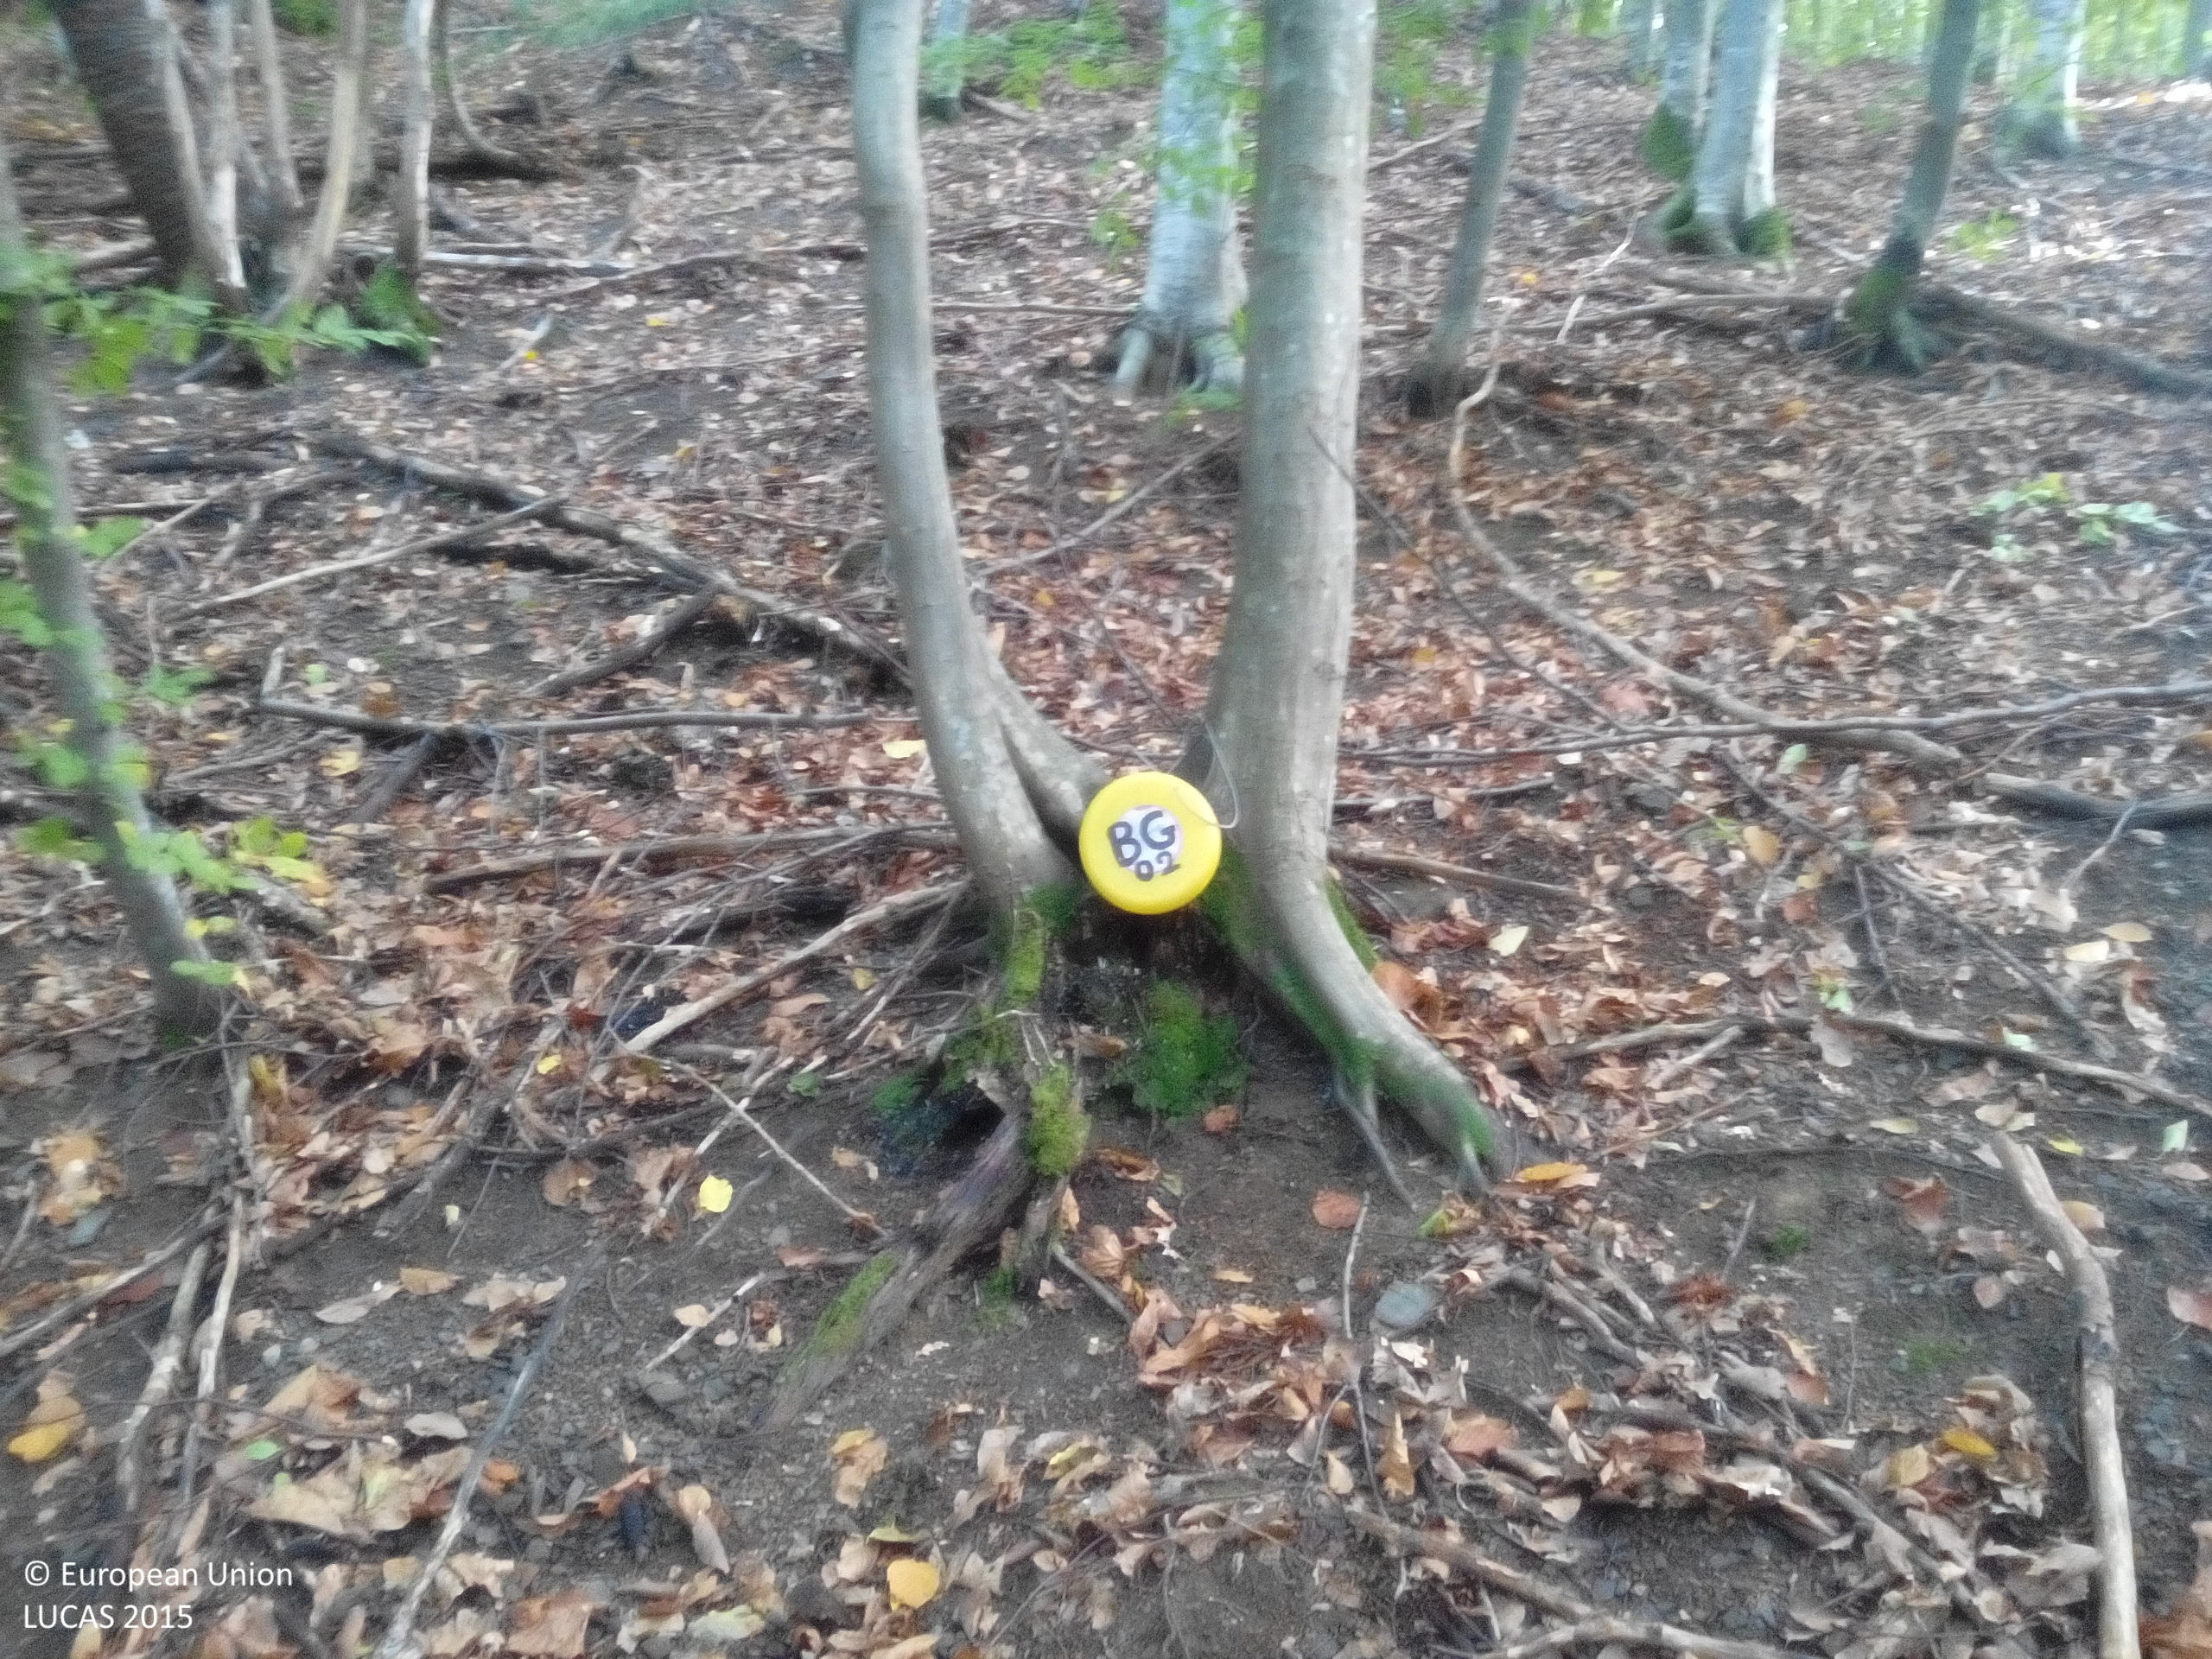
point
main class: Woodland
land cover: Broadleaved woodland
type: beech forest
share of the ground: > 75 %
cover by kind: broadleaved forest trees 100 %
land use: Forestry
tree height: > 5 m
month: October
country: BG
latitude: 42.8307
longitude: 24.3776
